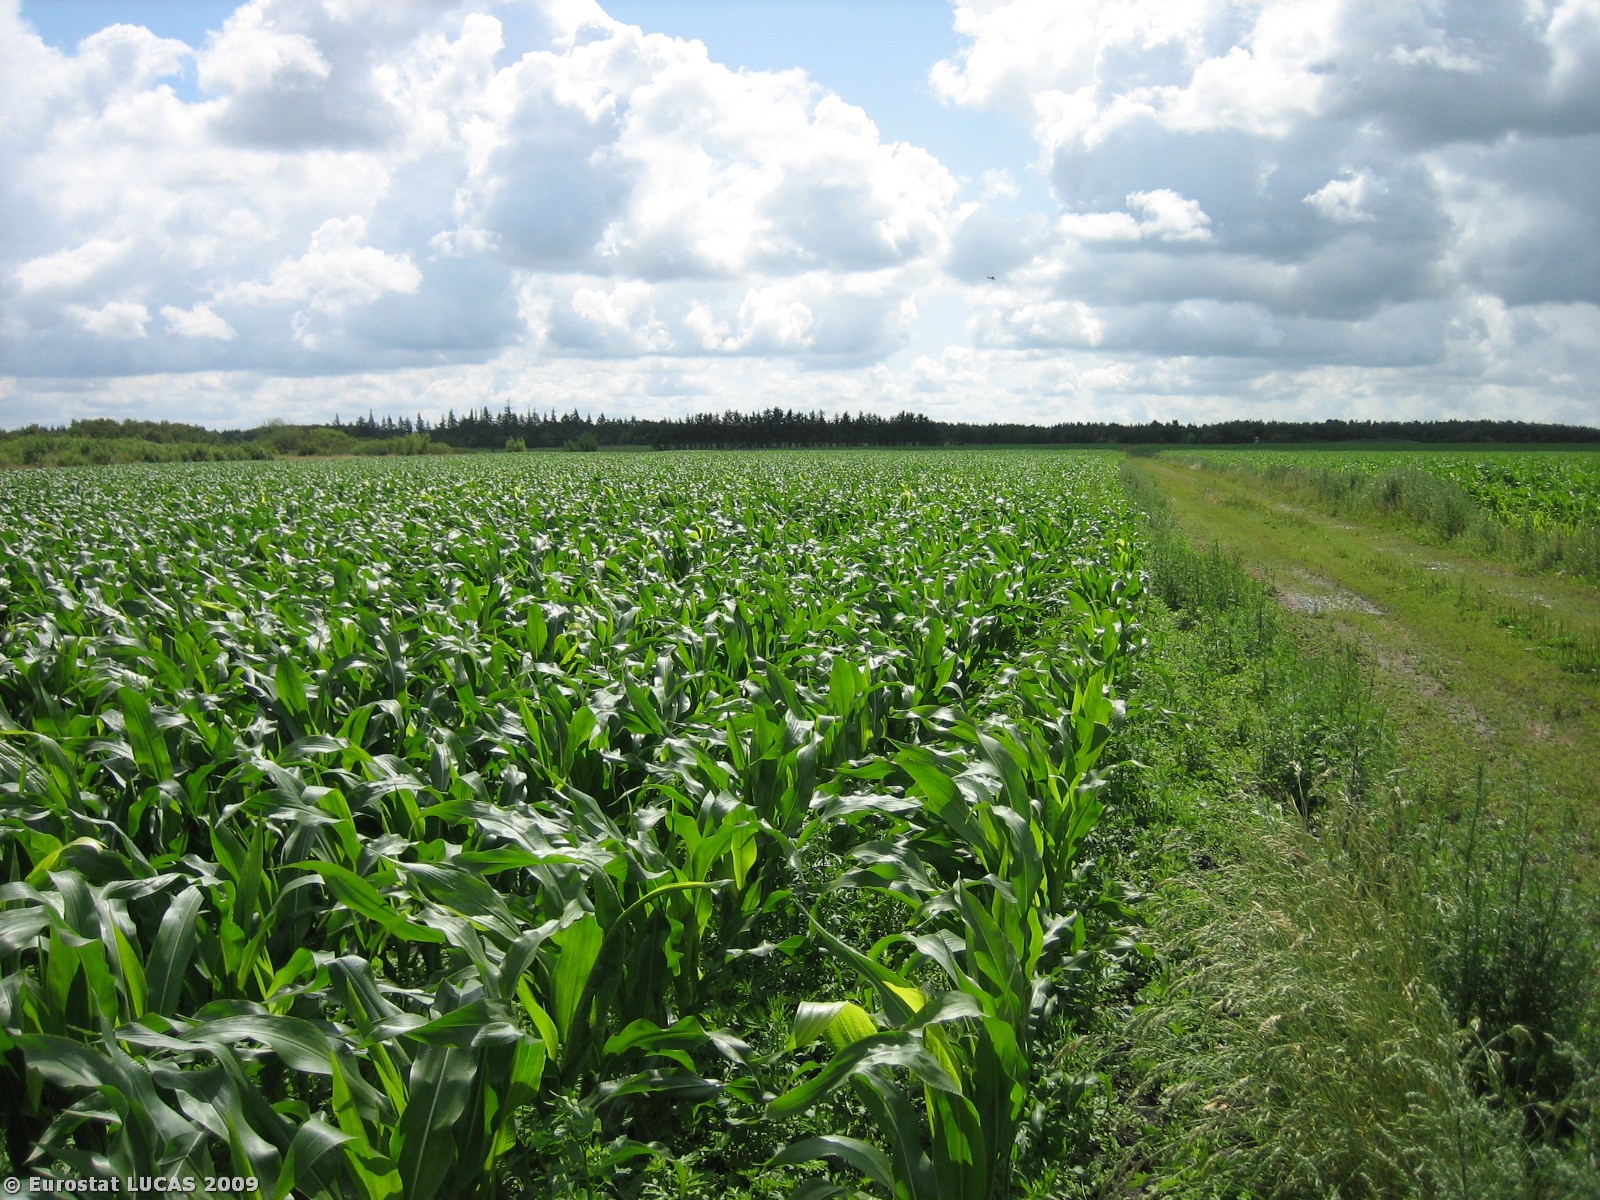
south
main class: Cropland
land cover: Maize
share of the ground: 25 - 50 %
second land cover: Spontaneously vegetated surfaces
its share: > 75 %
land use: Agriculture (excluding fallow land and kitchen gardens)
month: July
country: DK
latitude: 55.6426
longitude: 8.7778
